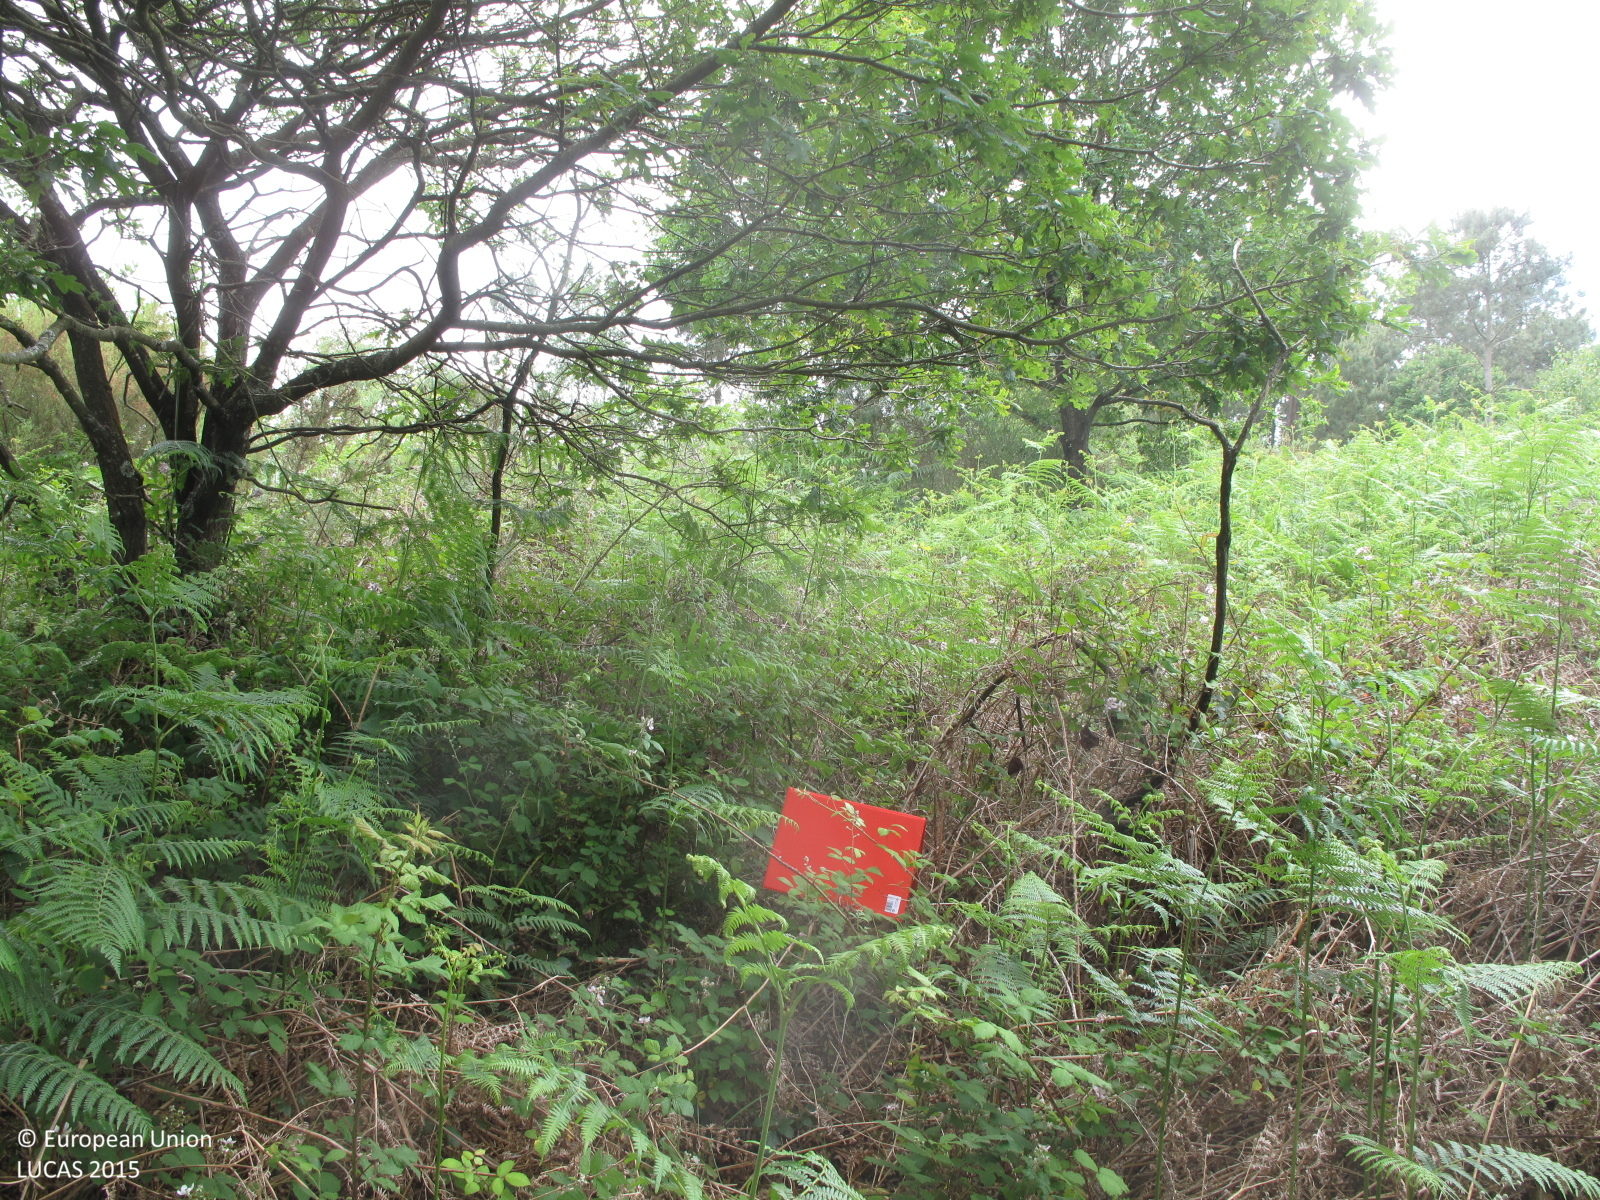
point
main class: Woodland
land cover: Broadleaved woodland
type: acidophilous oak and oak-birch forest
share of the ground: 50 - 75 %
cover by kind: broadleaved forest trees 60 %, shrubs 30 %, herbaceous plants 10 %
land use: Semi-natural and natural areas not in use
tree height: > 5 m
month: June
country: ES
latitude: 43.0943
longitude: -8.4977
